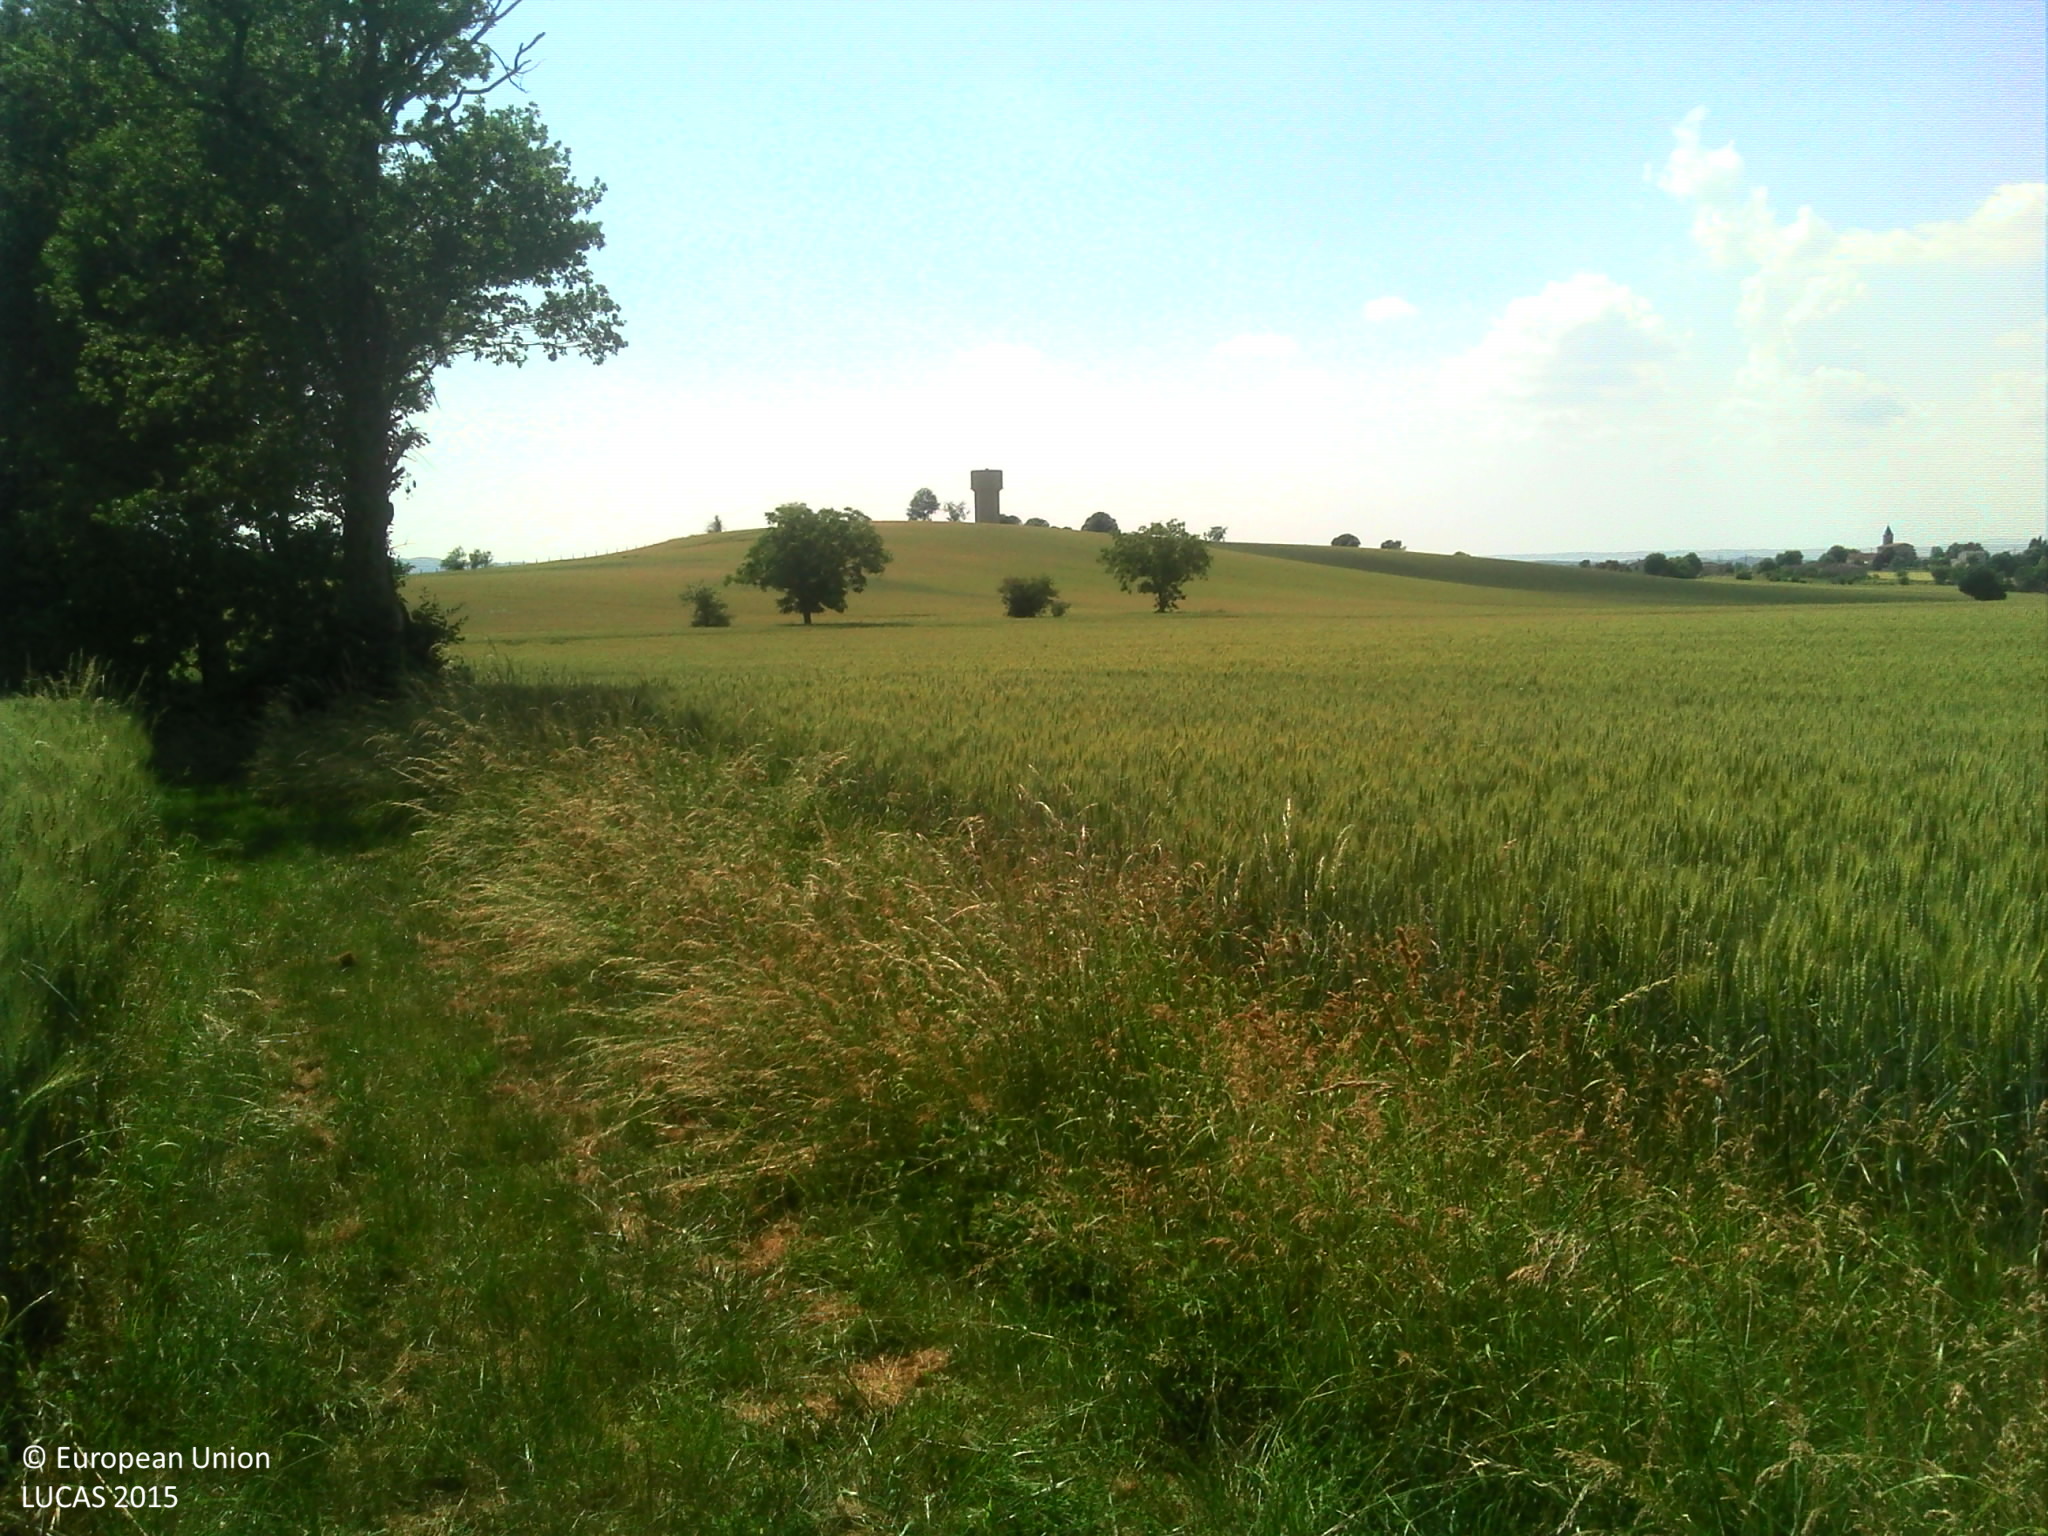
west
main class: Cropland
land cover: Common wheat
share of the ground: > 75 %
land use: Agriculture (excluding fallow land and kitchen gardens)
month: June
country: FR
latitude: 43.8501
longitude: 2.1049
